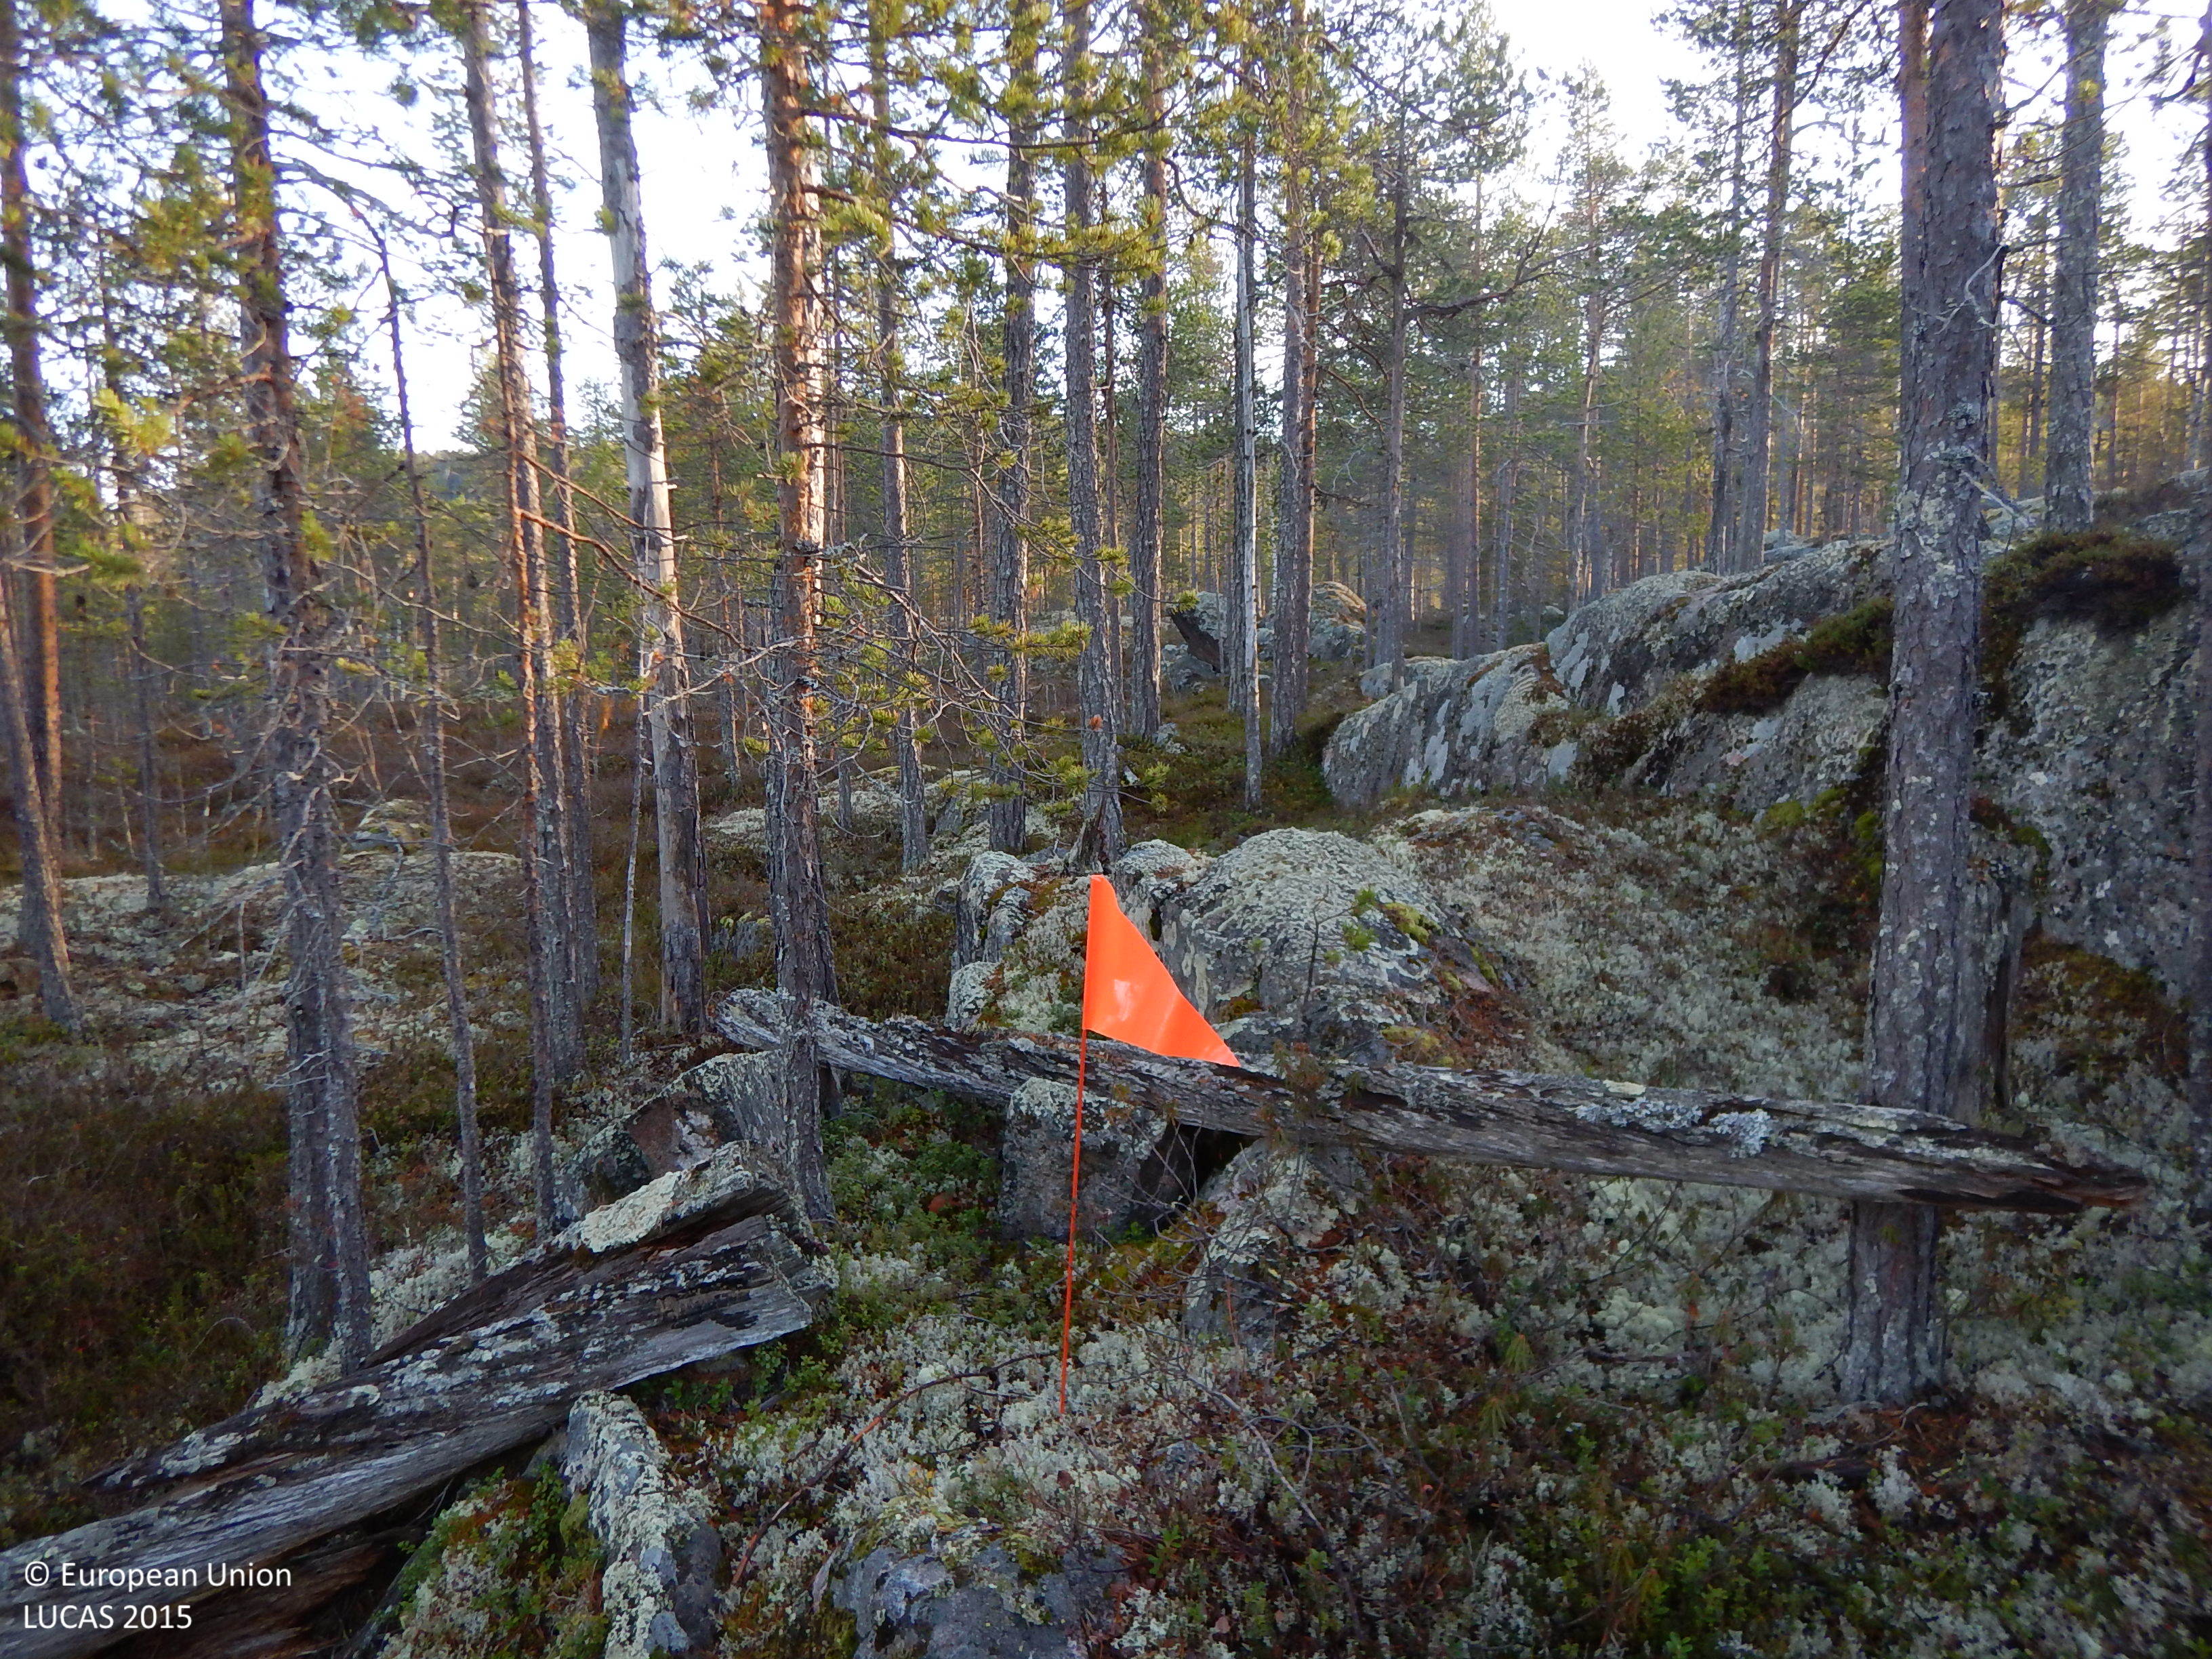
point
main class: Woodland
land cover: Pine dominated coniferous woodland
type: boreal forest
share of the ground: 50 - 75 %
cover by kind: coniferous forest trees 55 %, shrubs 15 %, herbaceous plants 10 %, lichens and mosses 10 %, consolidated bare surface 10 %
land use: Forestry
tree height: > 5 m
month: October
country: SE
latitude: 65.2713
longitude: 20.2300
